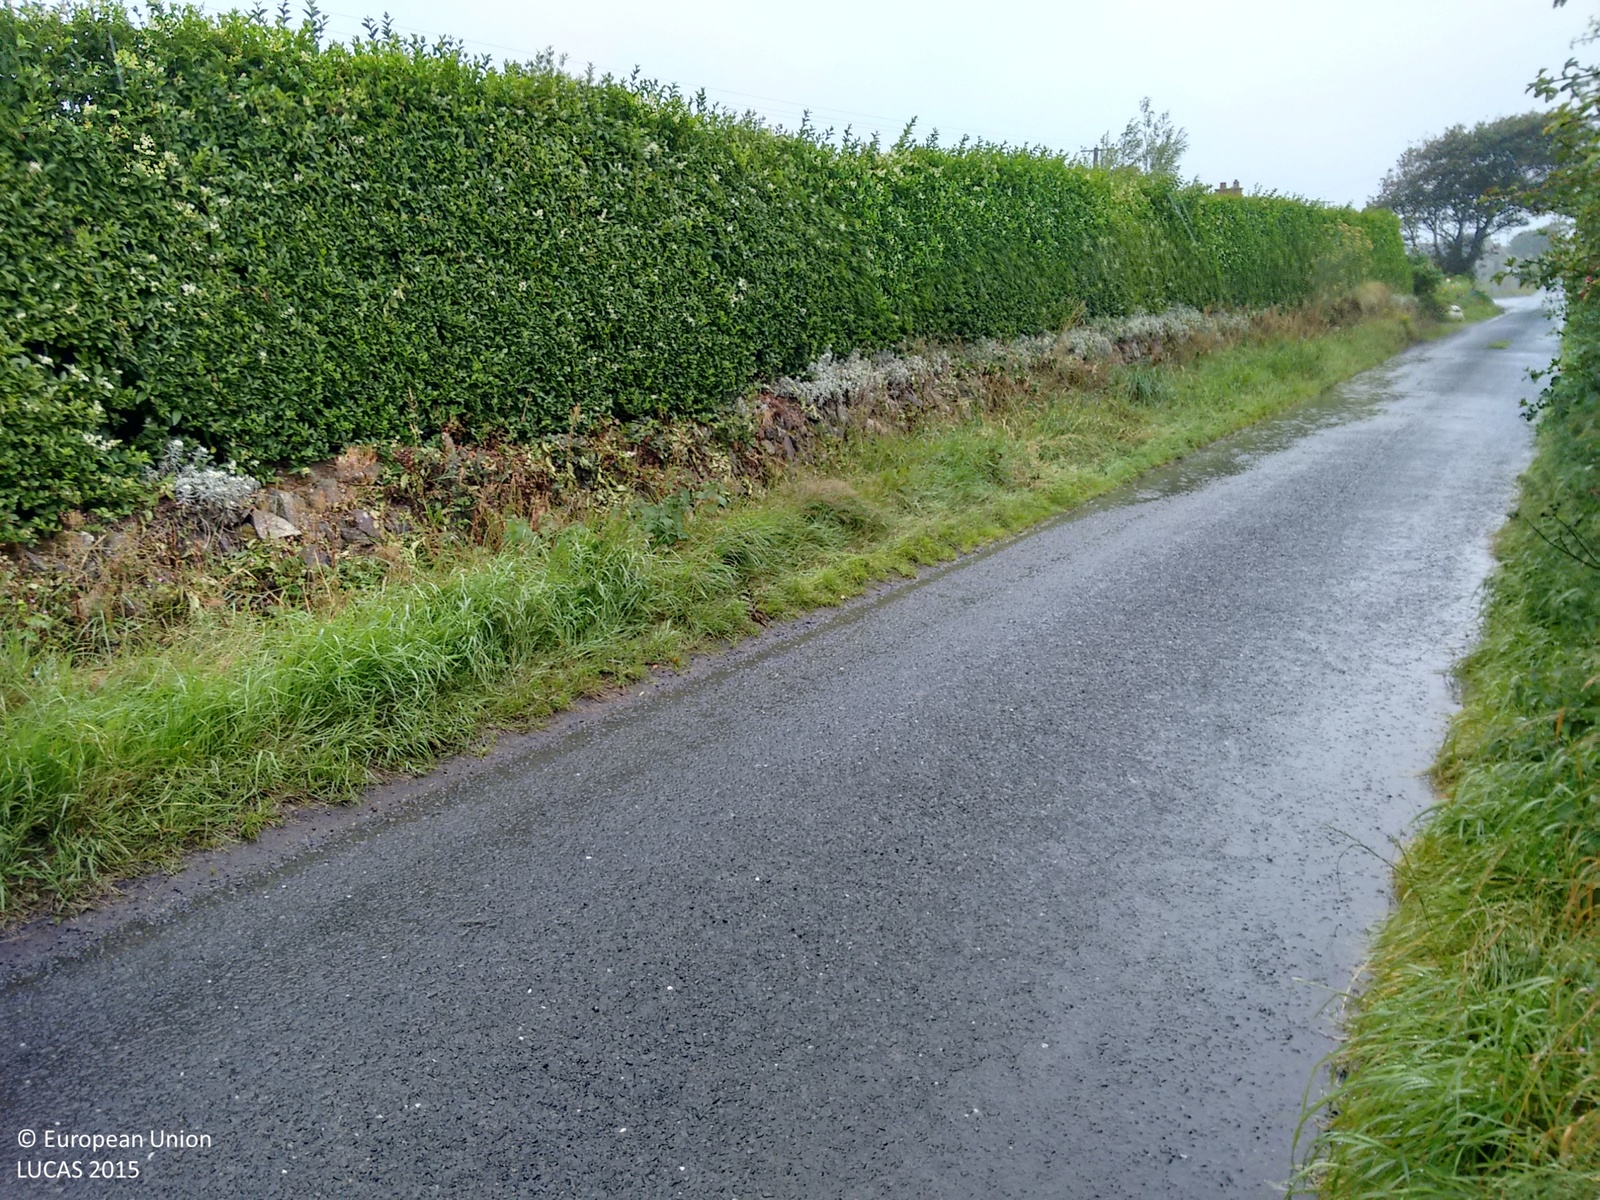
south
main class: Grassland
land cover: Grassland without tree/shrub cover
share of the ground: > 75 %
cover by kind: herbaceous plants 100 %
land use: Agriculture (excluding fallow land and kitchen gardens)
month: August
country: GB
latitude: 54.2716
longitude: -5.5936
